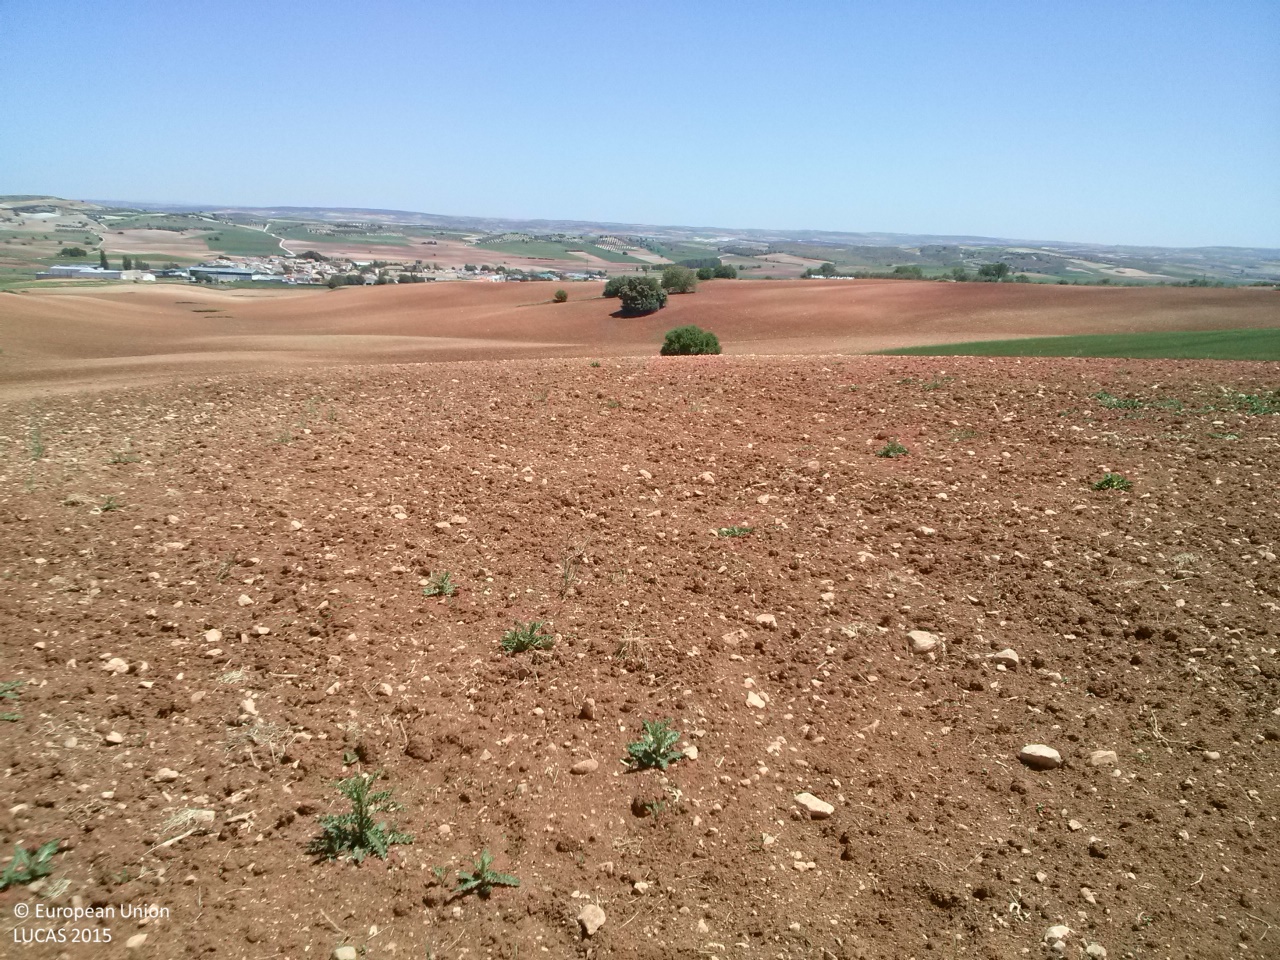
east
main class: Grassland
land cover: Spontaneously vegetated surfaces
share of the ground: 10 - 25 %
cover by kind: unconsolidated bare surface 85 %, herbaceous plants 15 %
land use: Fallow land
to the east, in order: Other bare soil; Barley; Single bushes/trees; Sunflower
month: May
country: ES
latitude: 39.7846
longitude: -2.7103
